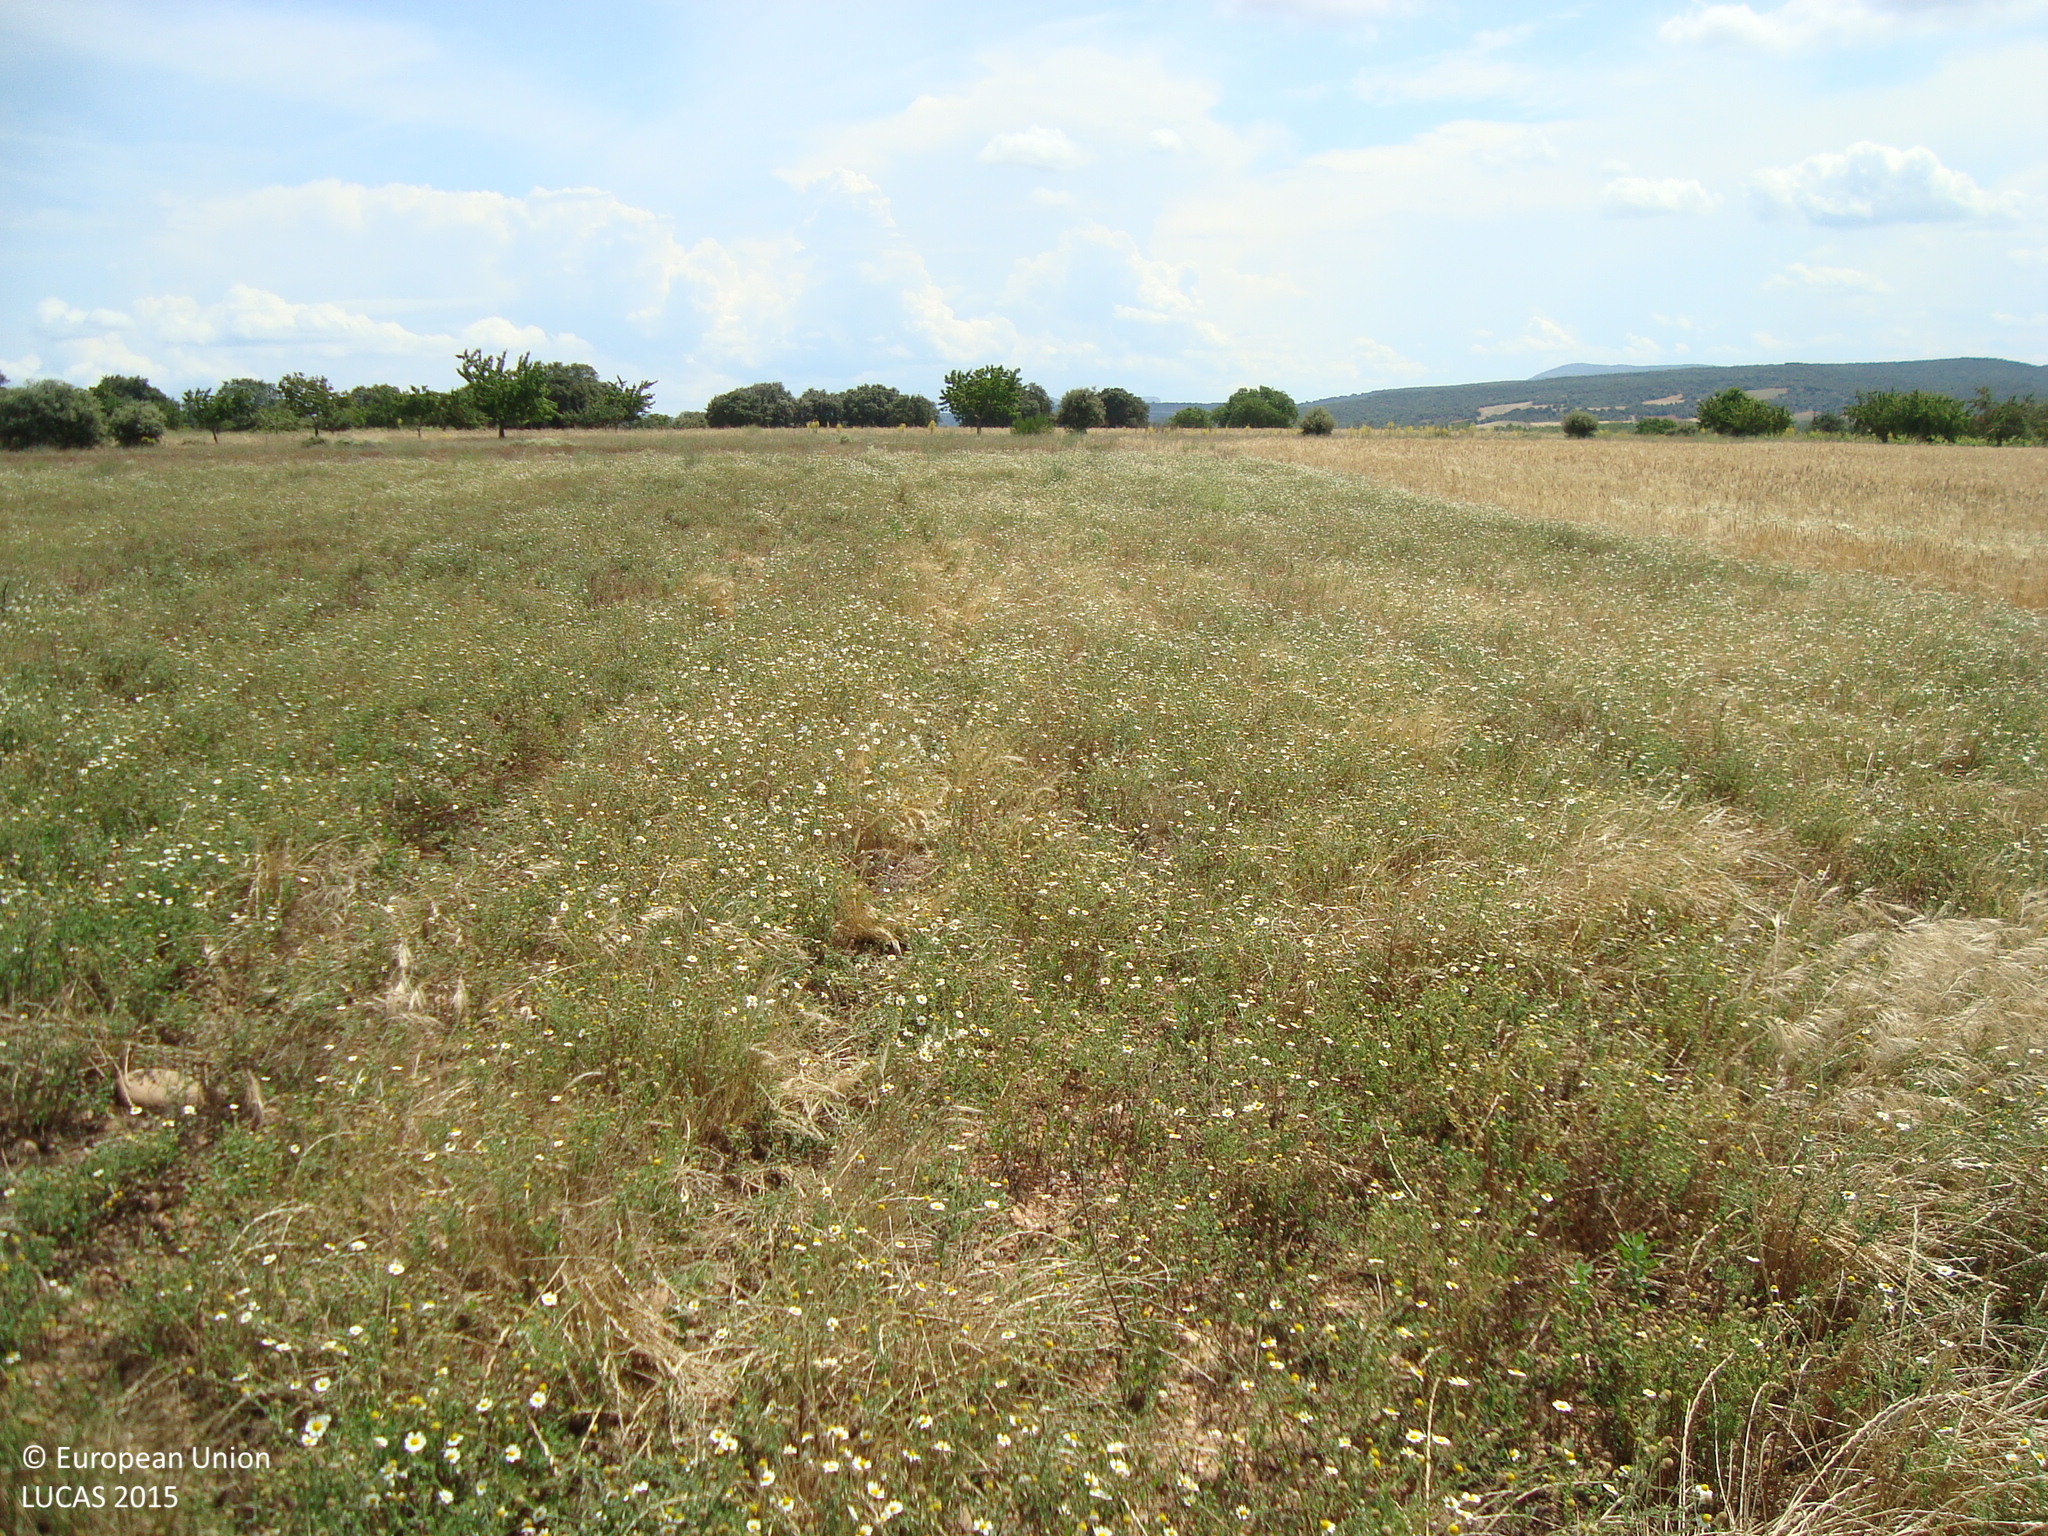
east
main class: Grassland
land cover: Spontaneously vegetated surfaces
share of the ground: > 75 %
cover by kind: herbaceous plants 95 %, unconsolidated bare surface 5 %
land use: Fallow land
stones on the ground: < 10 %
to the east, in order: Spontaneously vegetated surfaces; Tracks; Spontaneously vegetated surfaces; Single bushes/trees; Barley; Spontaneously vegetated surfaces; Broadleaved woodland
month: June
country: ES
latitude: 42.0431
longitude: -3.5984
